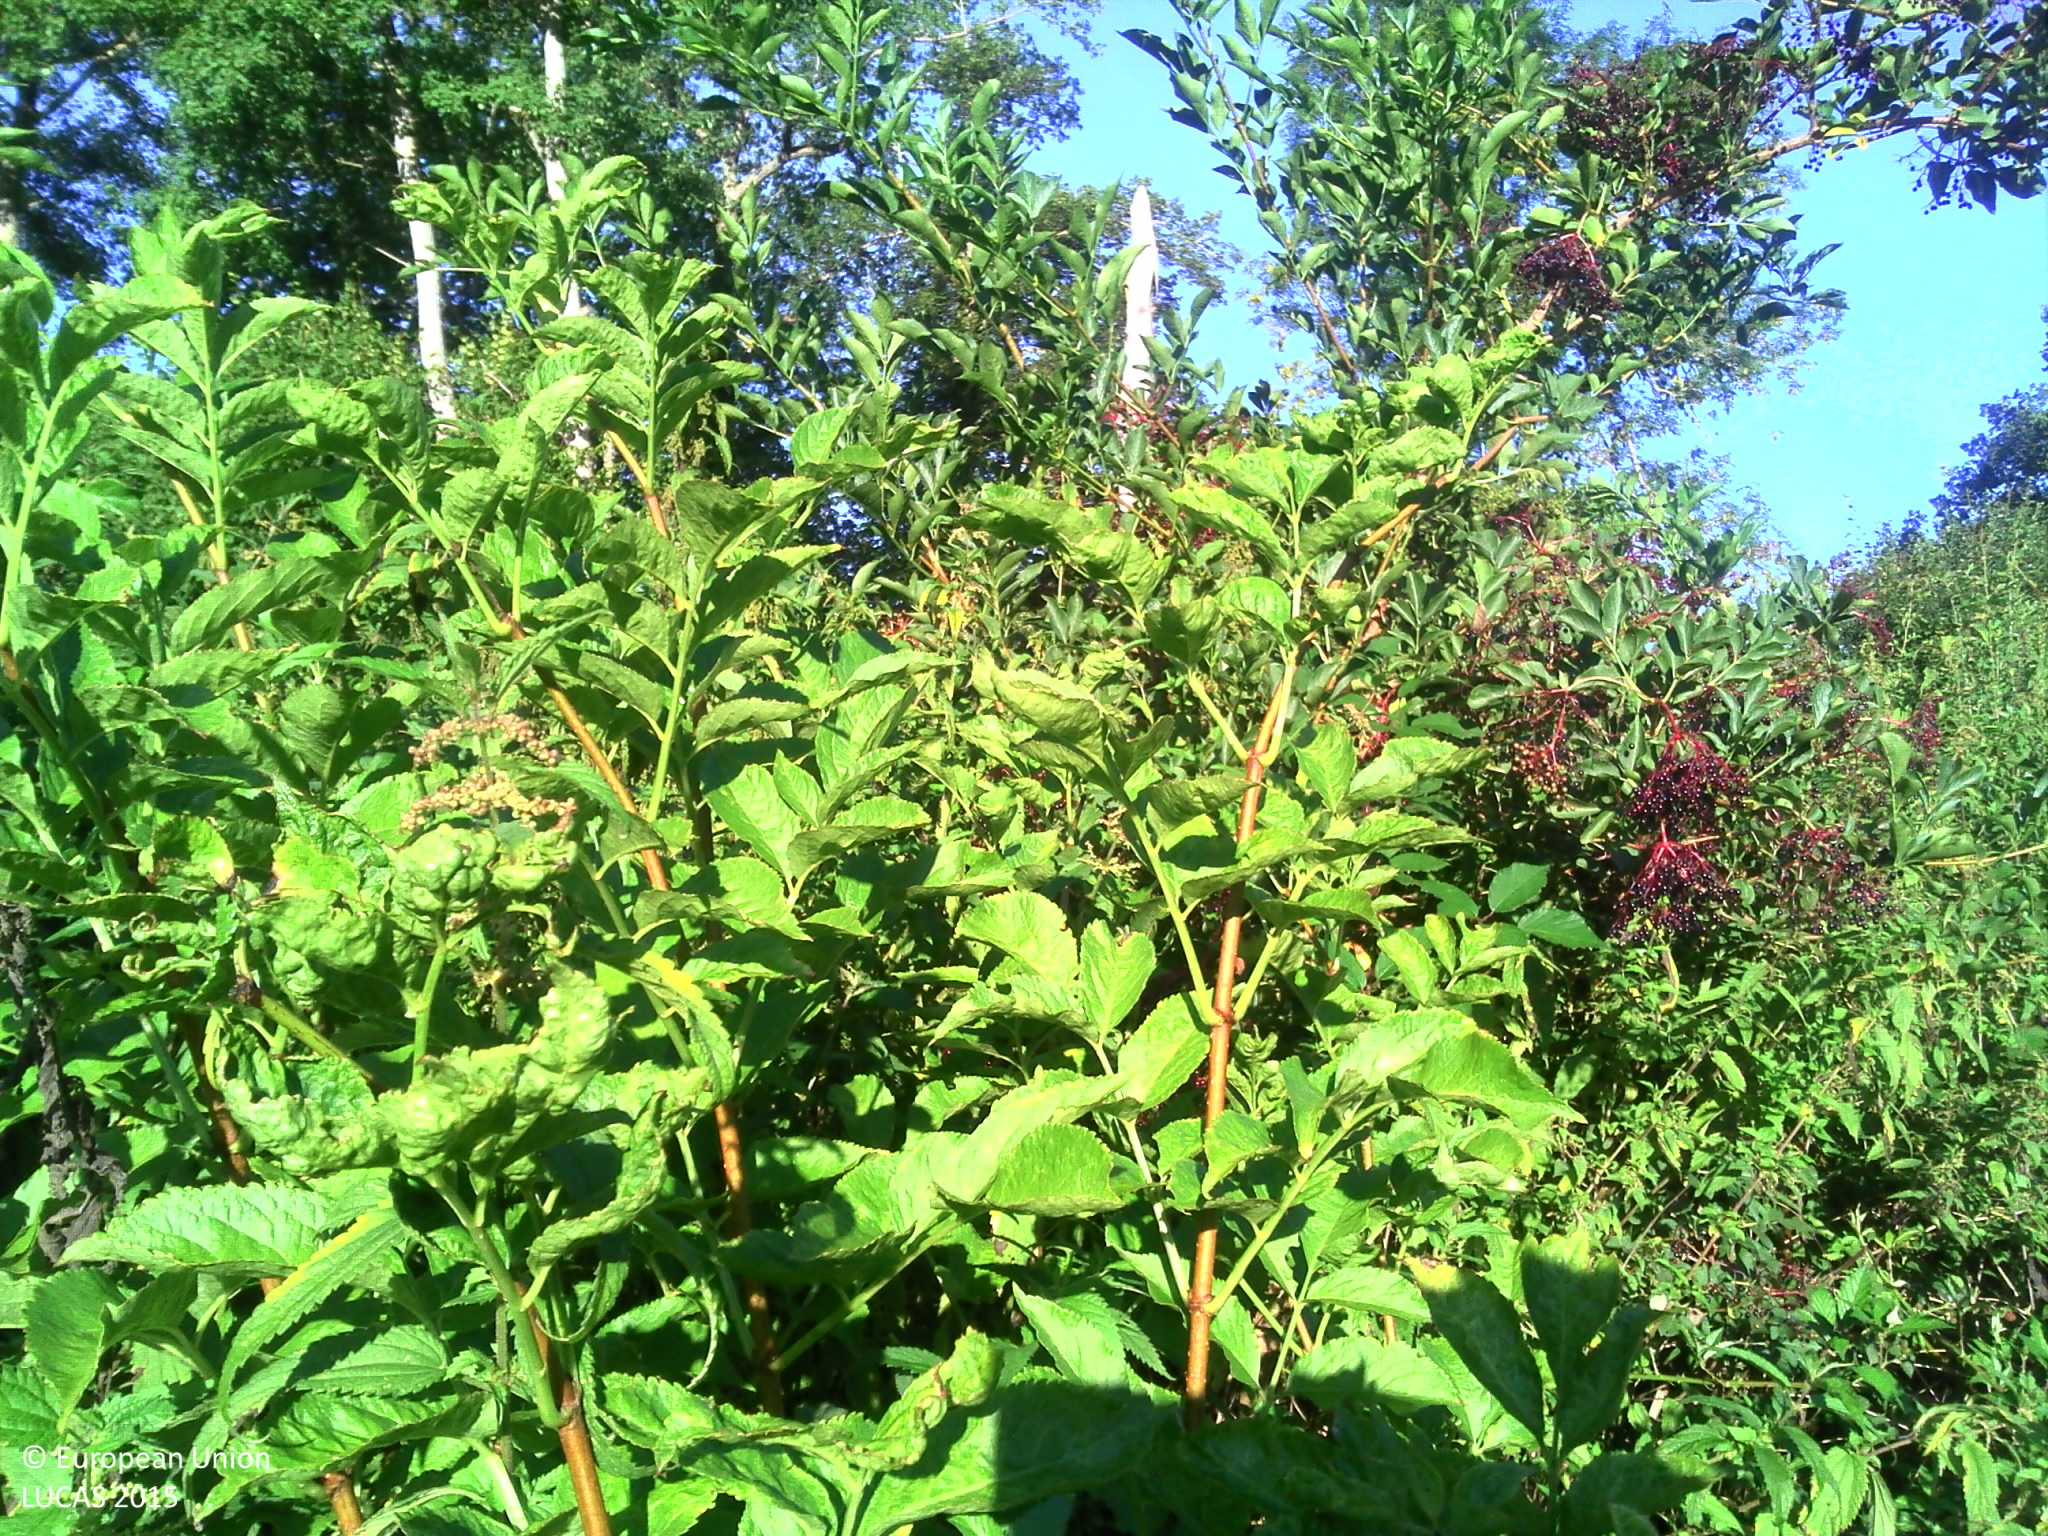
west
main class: Shrubland
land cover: Shrubland with sparse tree cover
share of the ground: > 75 %
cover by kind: herbaceous plants 55 %, shrubs 40 %, broadleaved forest trees 5 %
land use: Semi-natural and natural areas not in use
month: August
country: FR
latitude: 45.8389
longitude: 2.3100
